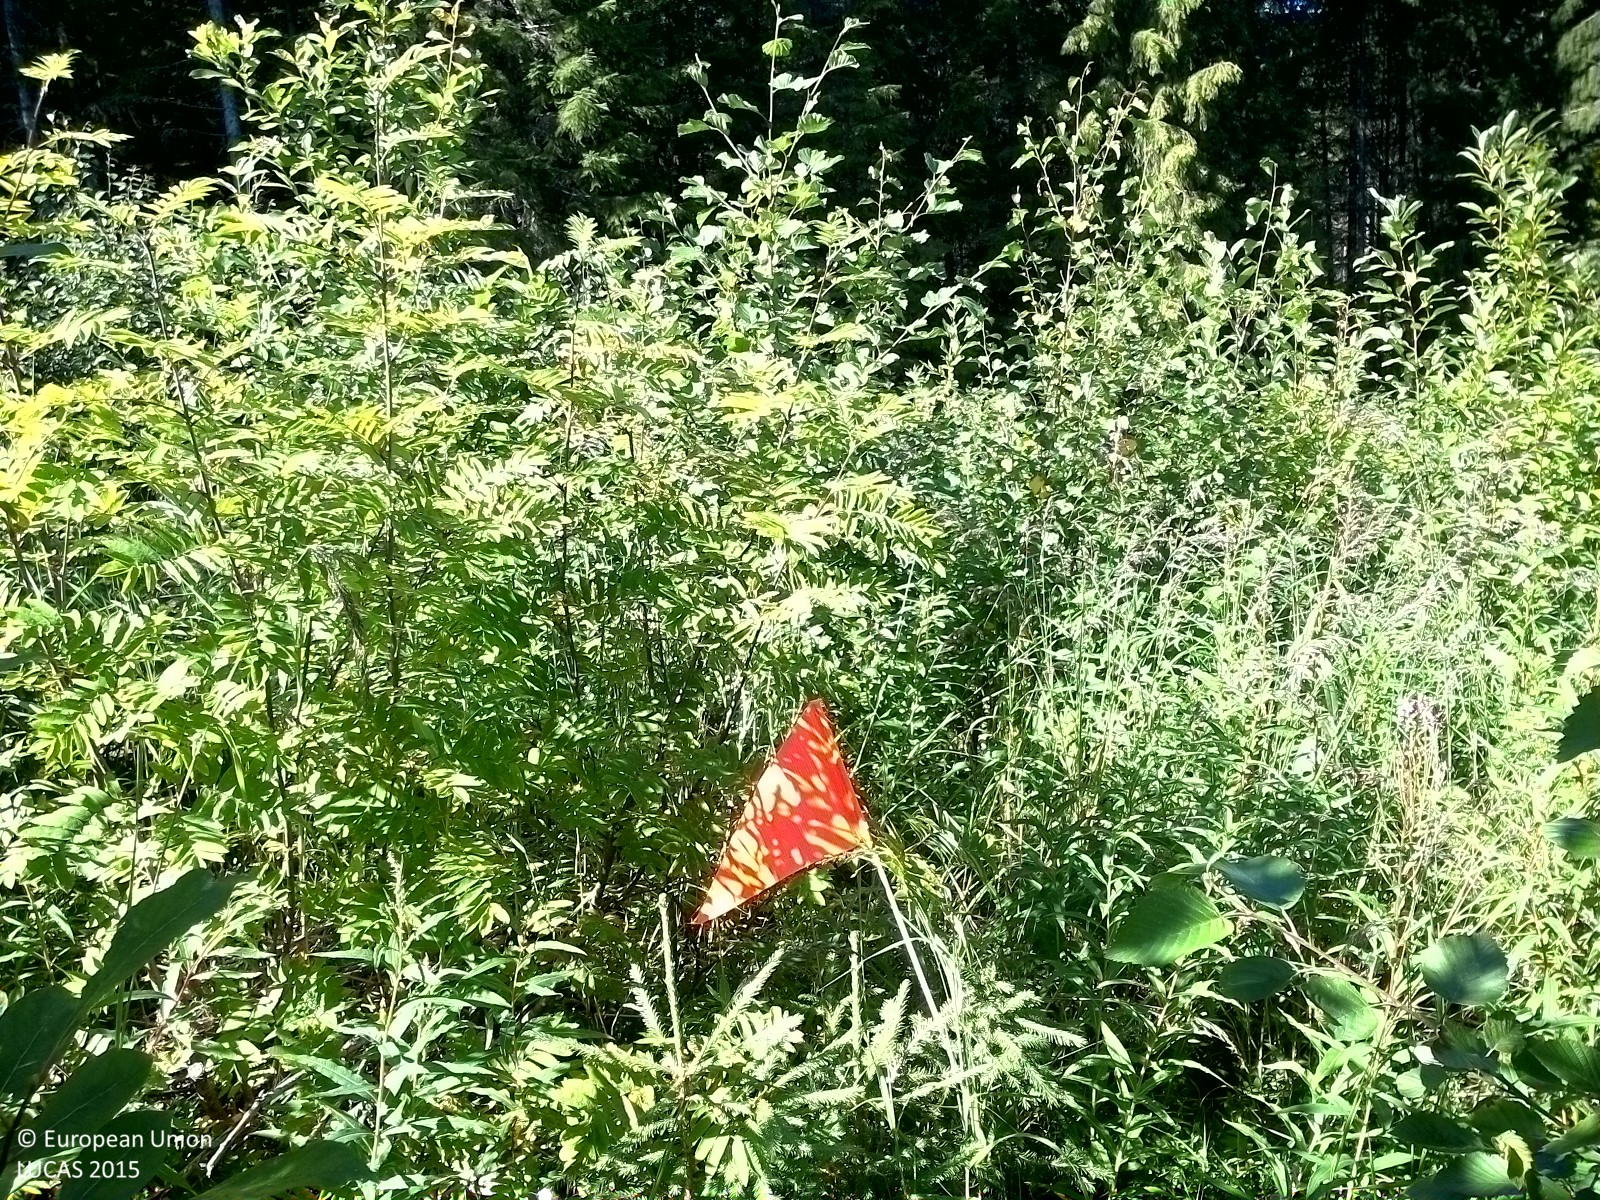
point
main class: Artificial land
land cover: Other artificial areas
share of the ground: > 75 %
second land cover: Broadleaved woodland
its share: > 75 %
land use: Electricity, gas and thermal power distribution
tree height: < 5 m
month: August
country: SE
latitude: 62.3295
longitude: 16.4464
